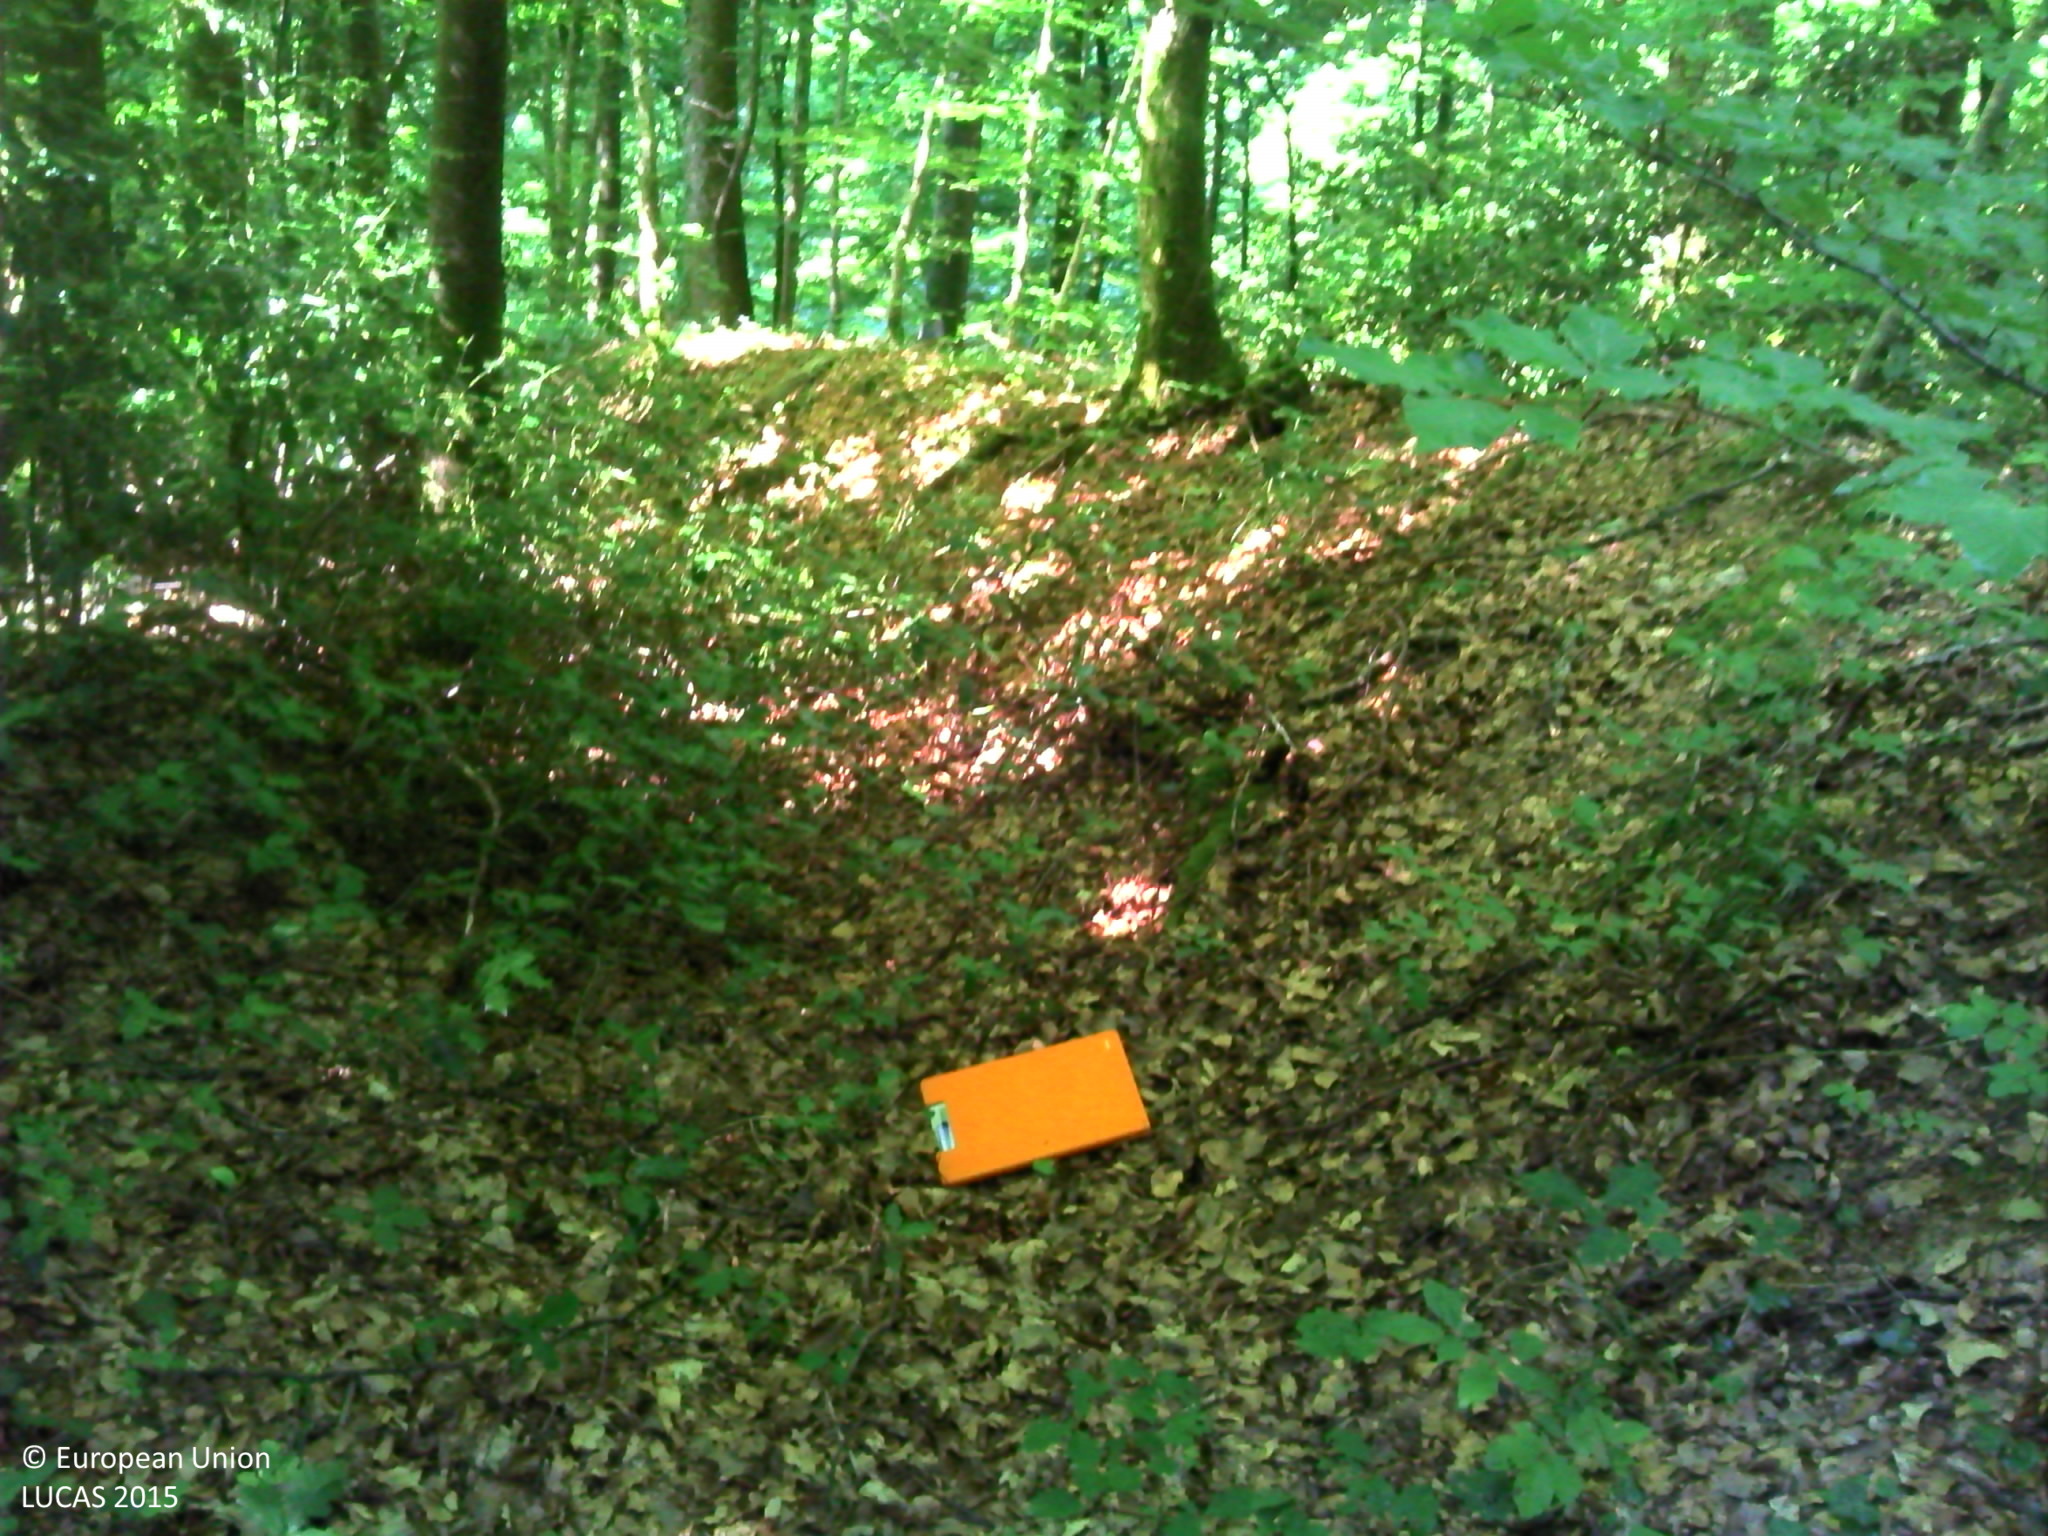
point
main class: Woodland
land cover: Broadleaved woodland
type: beech forest
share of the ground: > 75 %
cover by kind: broadleaved forest trees 95 %, herbaceous plants 5 %
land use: Forestry
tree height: > 5 m
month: June
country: FR
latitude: 47.4174
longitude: 6.1445
